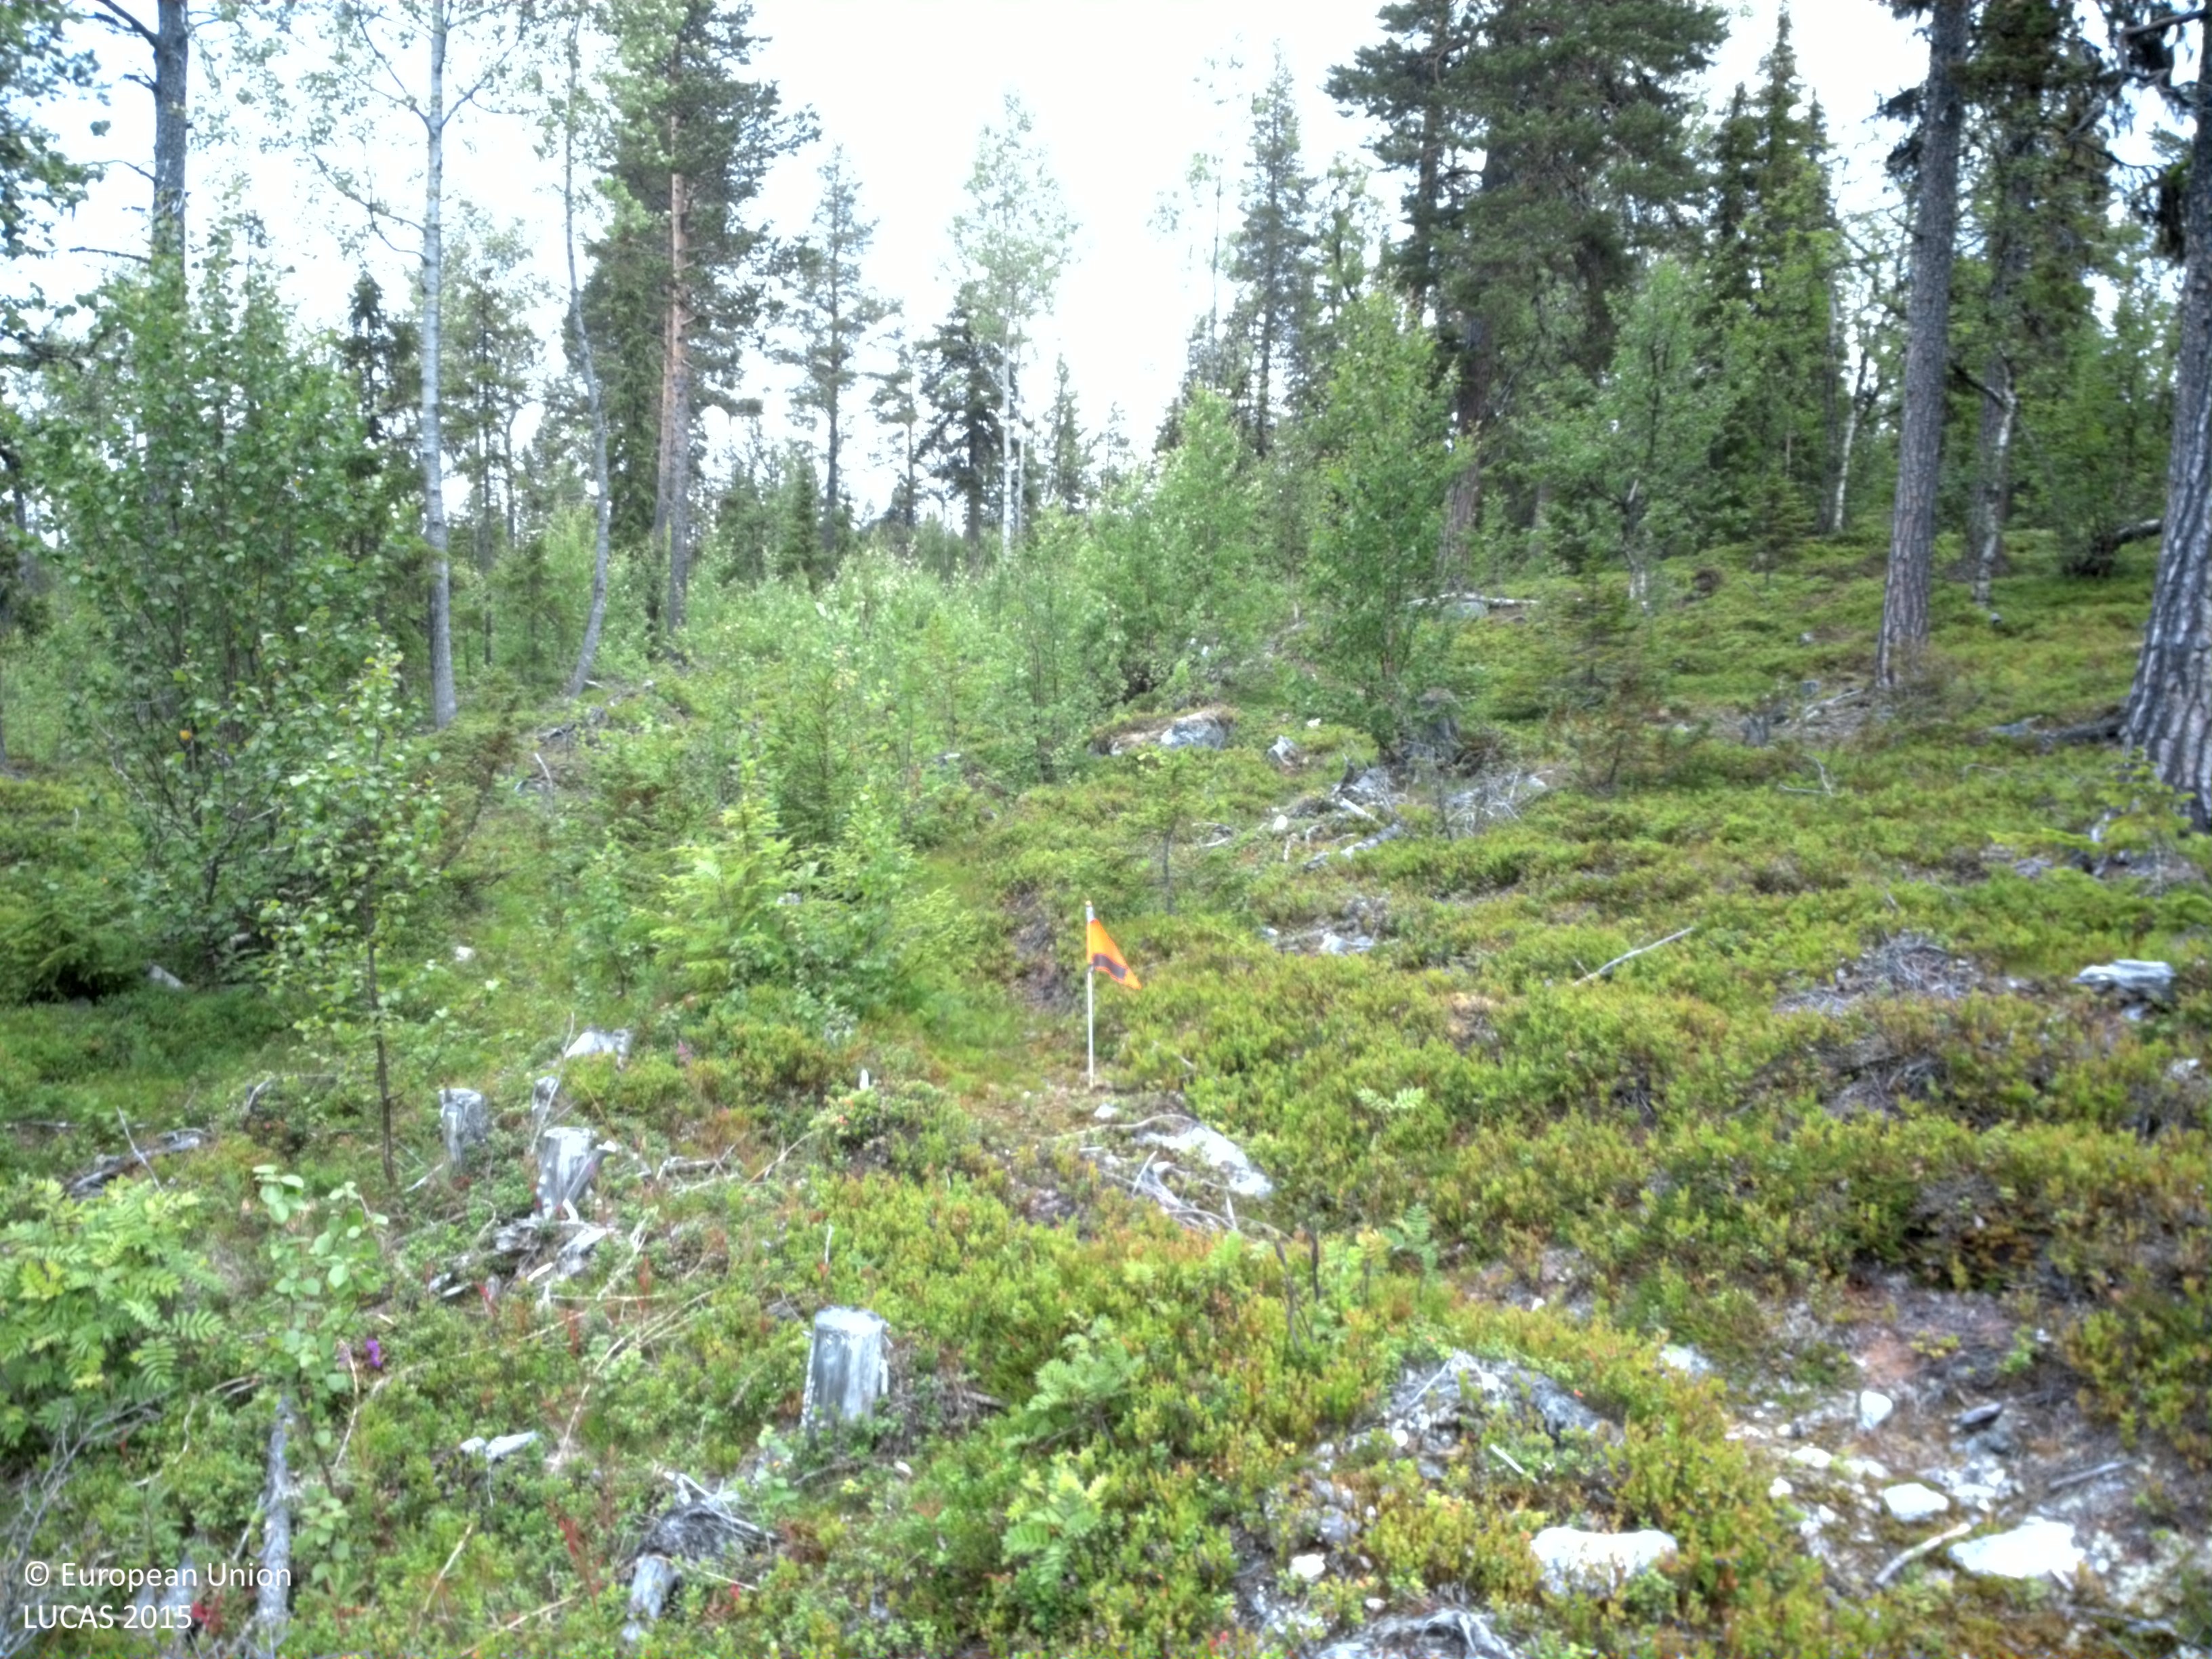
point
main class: Woodland
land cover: Other mixed woodland
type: boreal forest
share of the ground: 10 - 25 %
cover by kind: shrubs 65 %, coniferous forest trees 15 %, lichens and mosses 10 %, broadleaved forest trees 5 %, herbaceous plants 5 %
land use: Forestry
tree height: > 5 m
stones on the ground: < 10 %
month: August
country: SE
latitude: 64.9369
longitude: 15.4897
